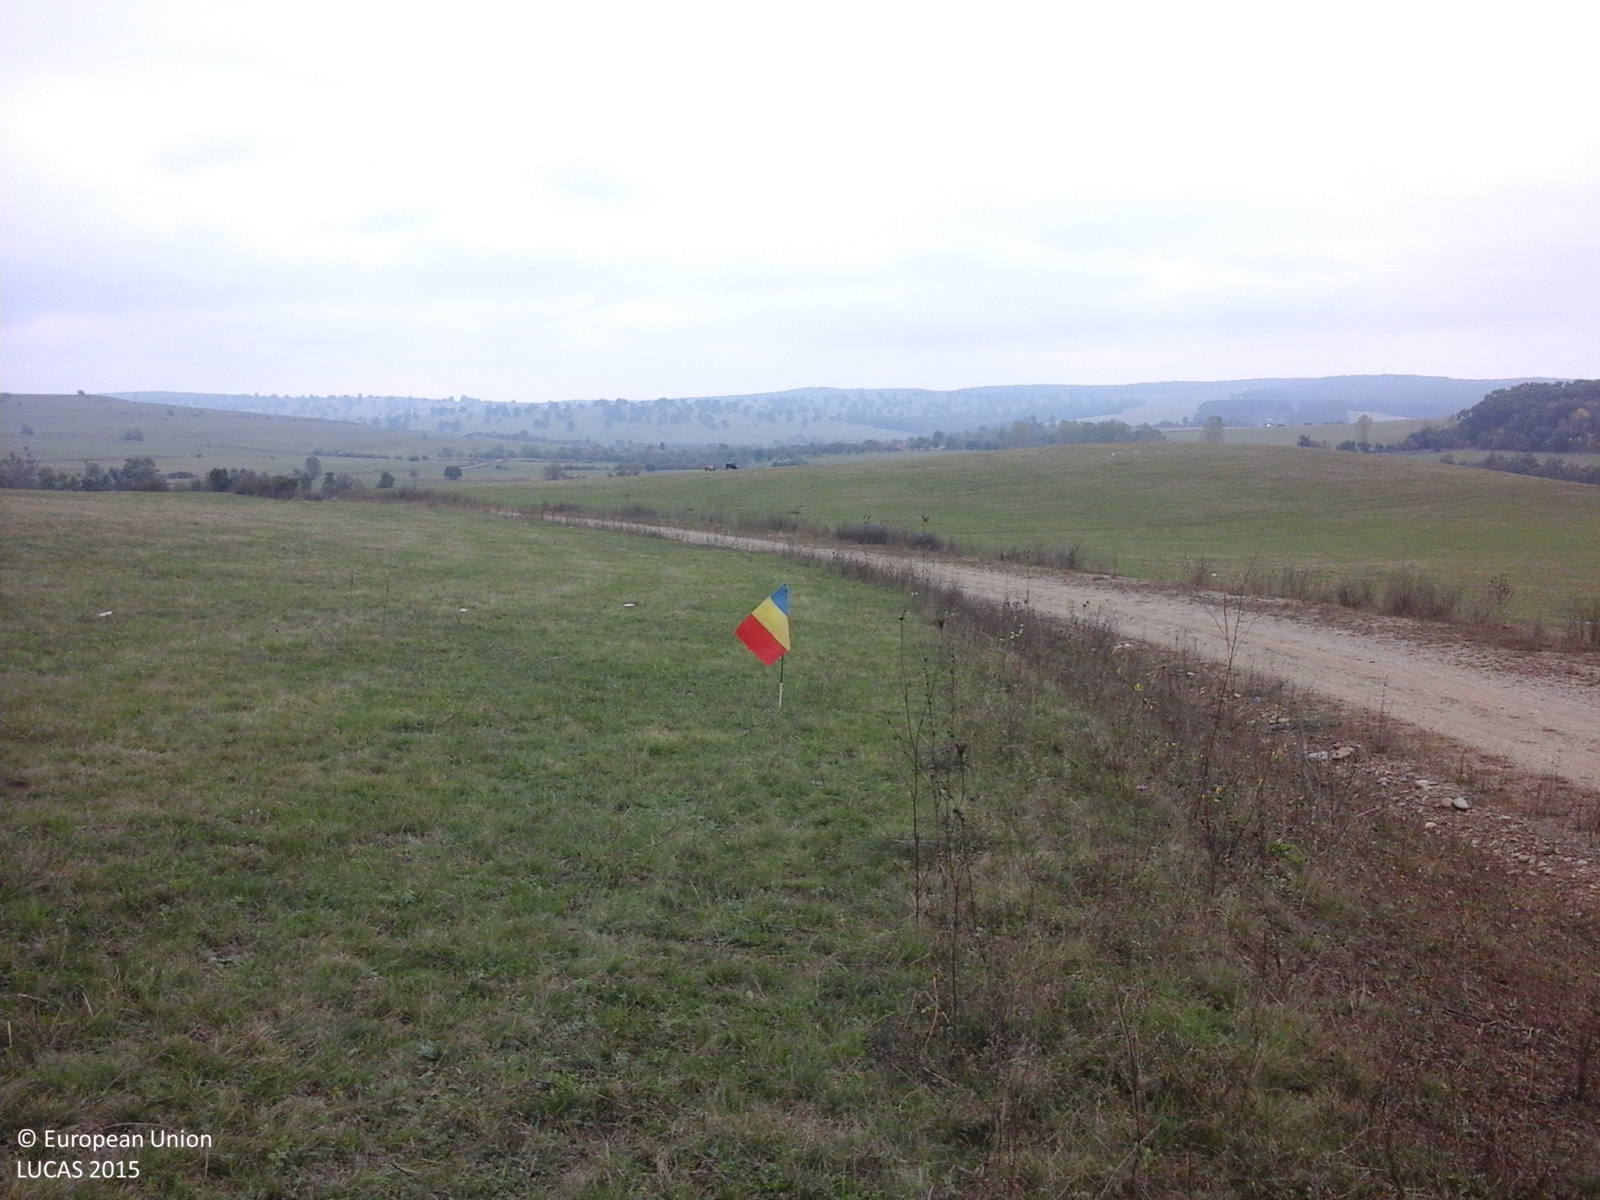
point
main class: Grassland
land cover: Grassland without tree/shrub cover
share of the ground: > 75 %
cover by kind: herbaceous plants 100 %
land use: Agriculture (excluding fallow land and kitchen gardens)
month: October
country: RO
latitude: 45.9492
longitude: 25.0989
